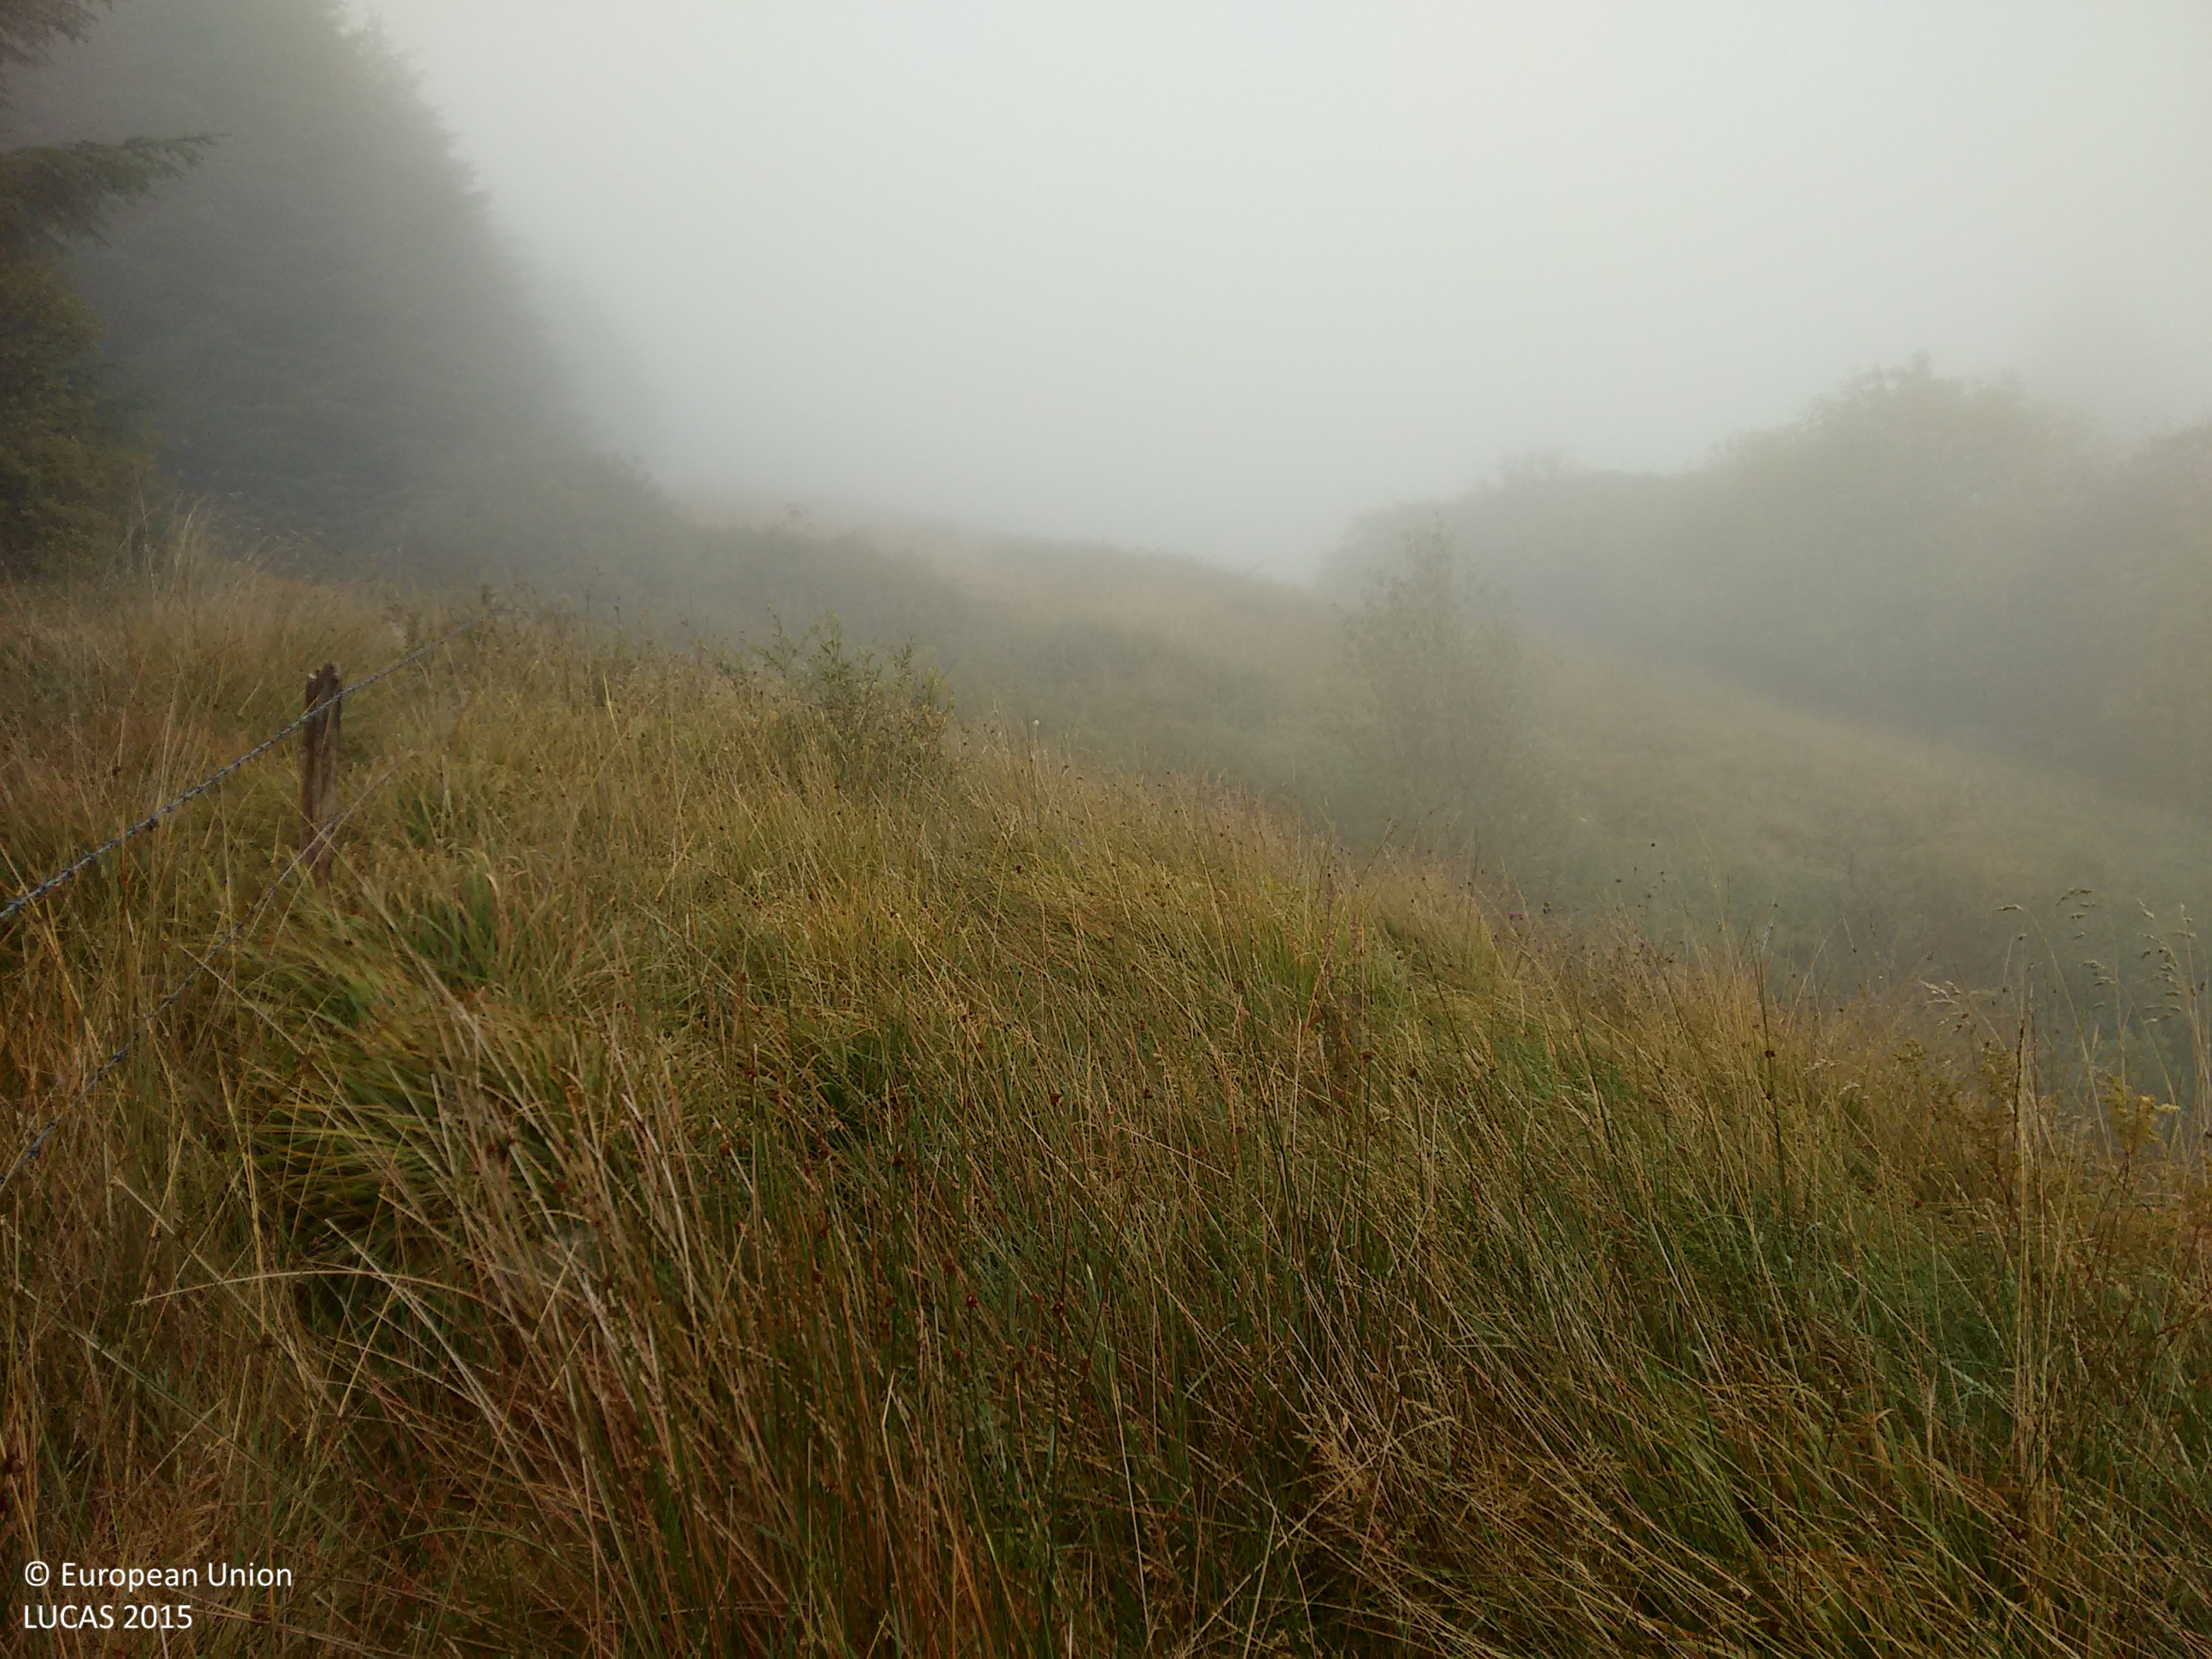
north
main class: Woodland
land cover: Spruce dominated coniferous woodland
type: exotic forest
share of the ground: > 75 %
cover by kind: coniferous forest trees 100 %
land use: Forestry
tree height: > 5 m
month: September
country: IE
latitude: 53.0753
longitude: -9.2543
